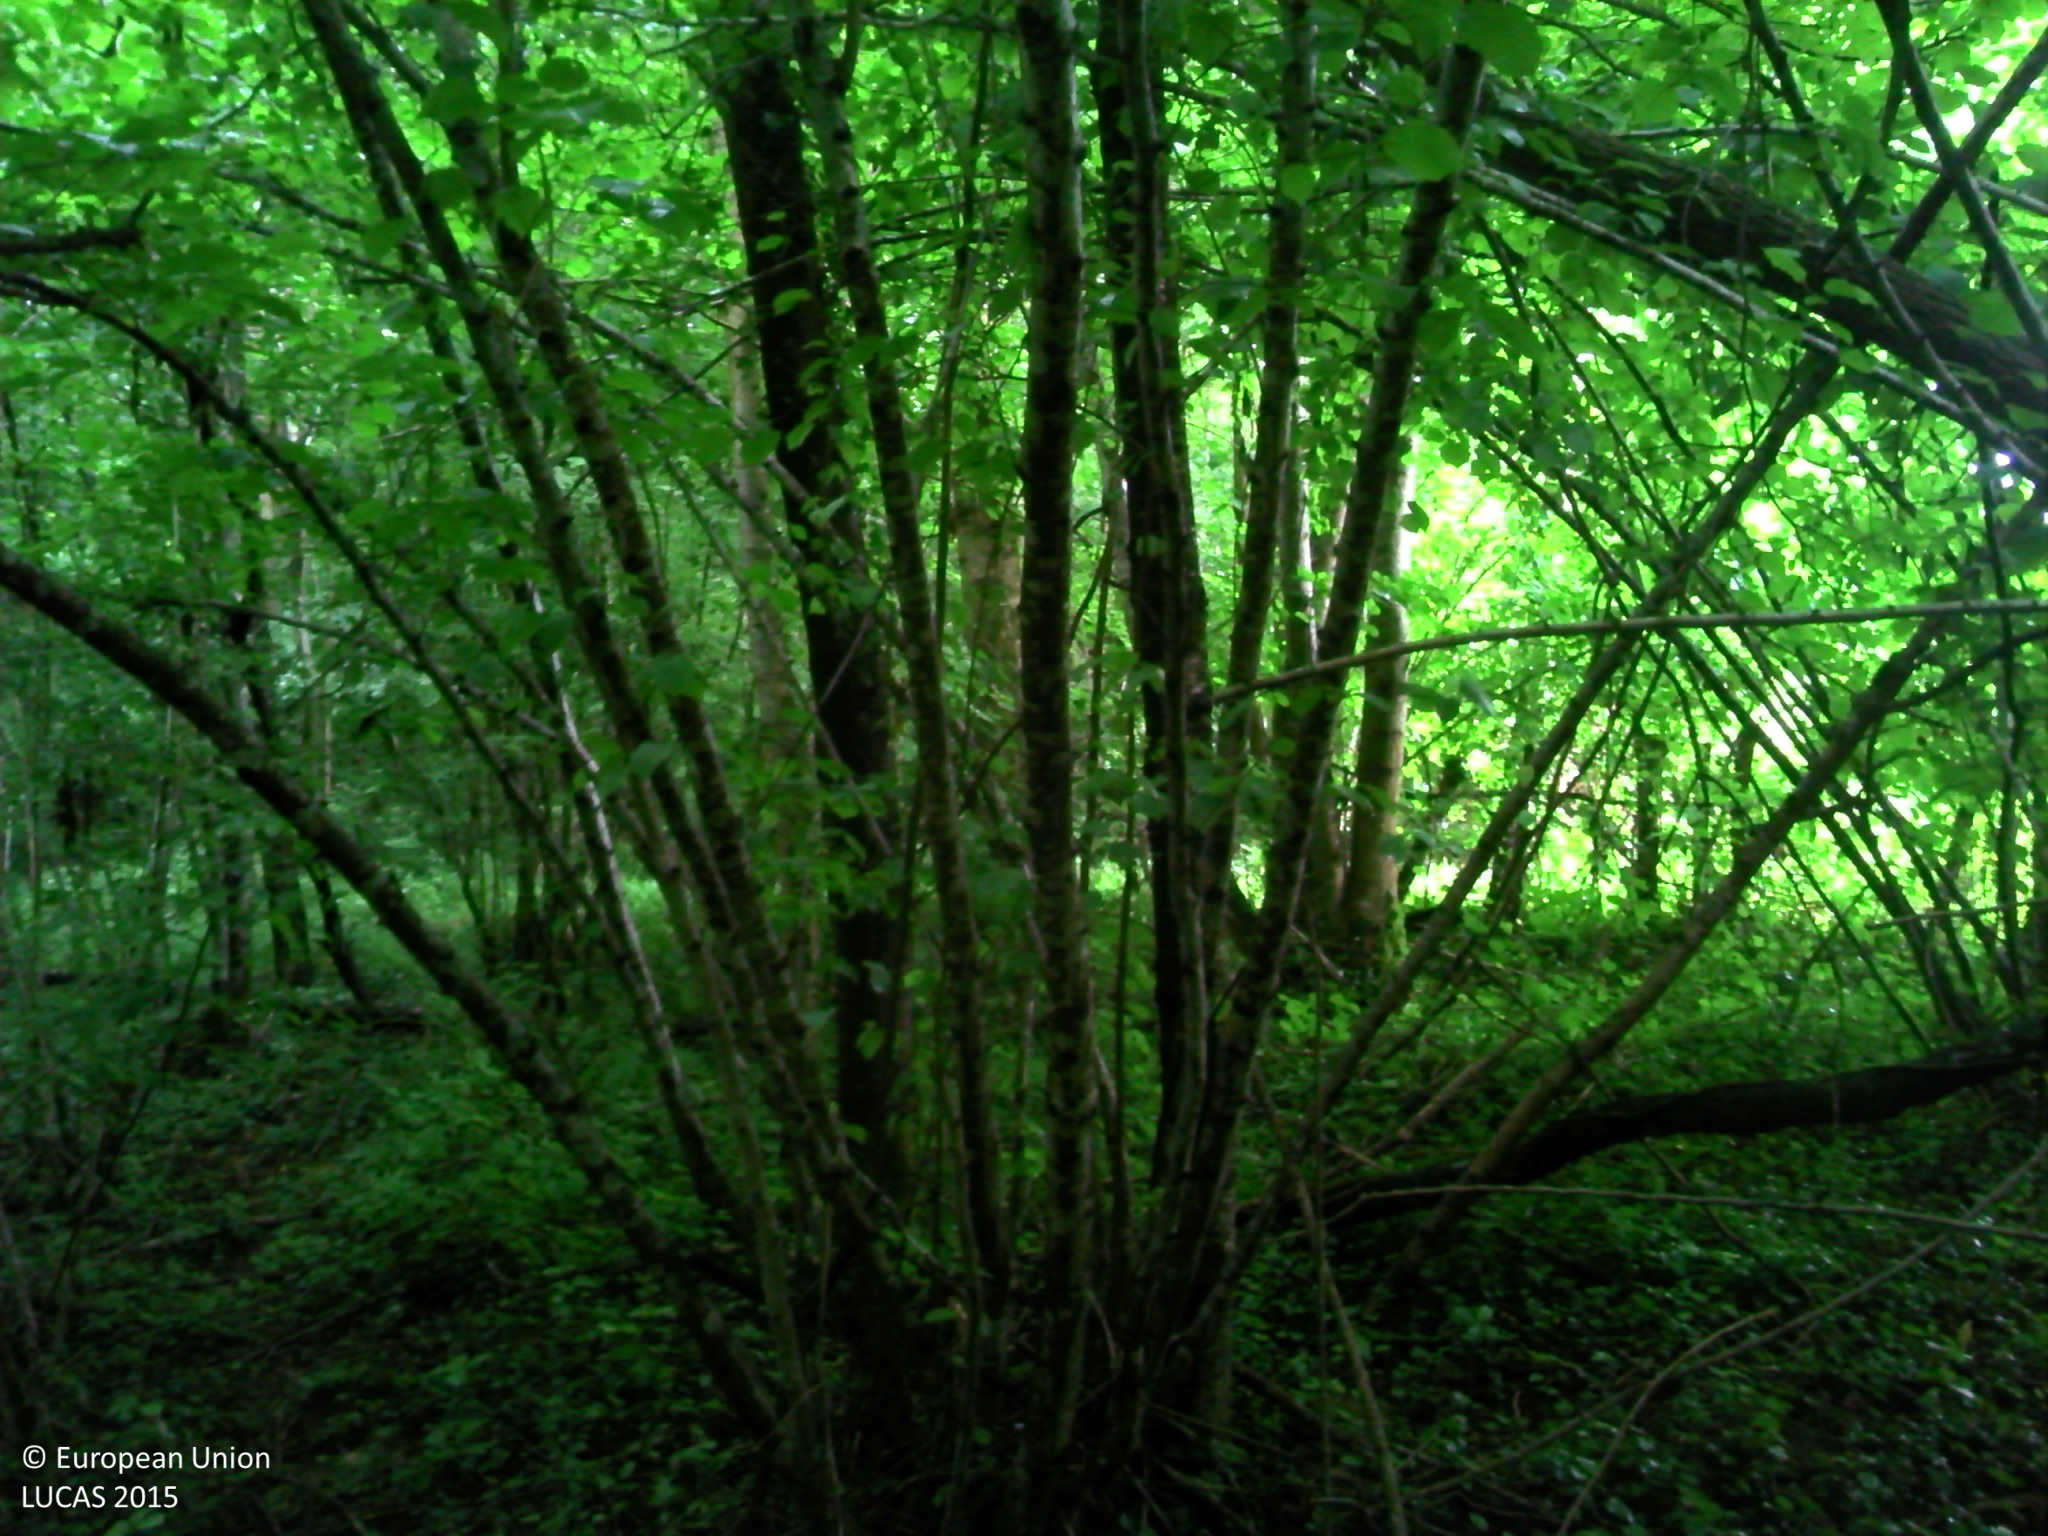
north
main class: Woodland
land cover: Broadleaved woodland
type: mesophytic deciduous forest
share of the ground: > 75 %
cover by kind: broadleaved forest trees 90 %, herbaceous plants 10 %
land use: Forestry
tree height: > 5 m
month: June
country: FR
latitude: 46.6285
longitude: 5.3395
